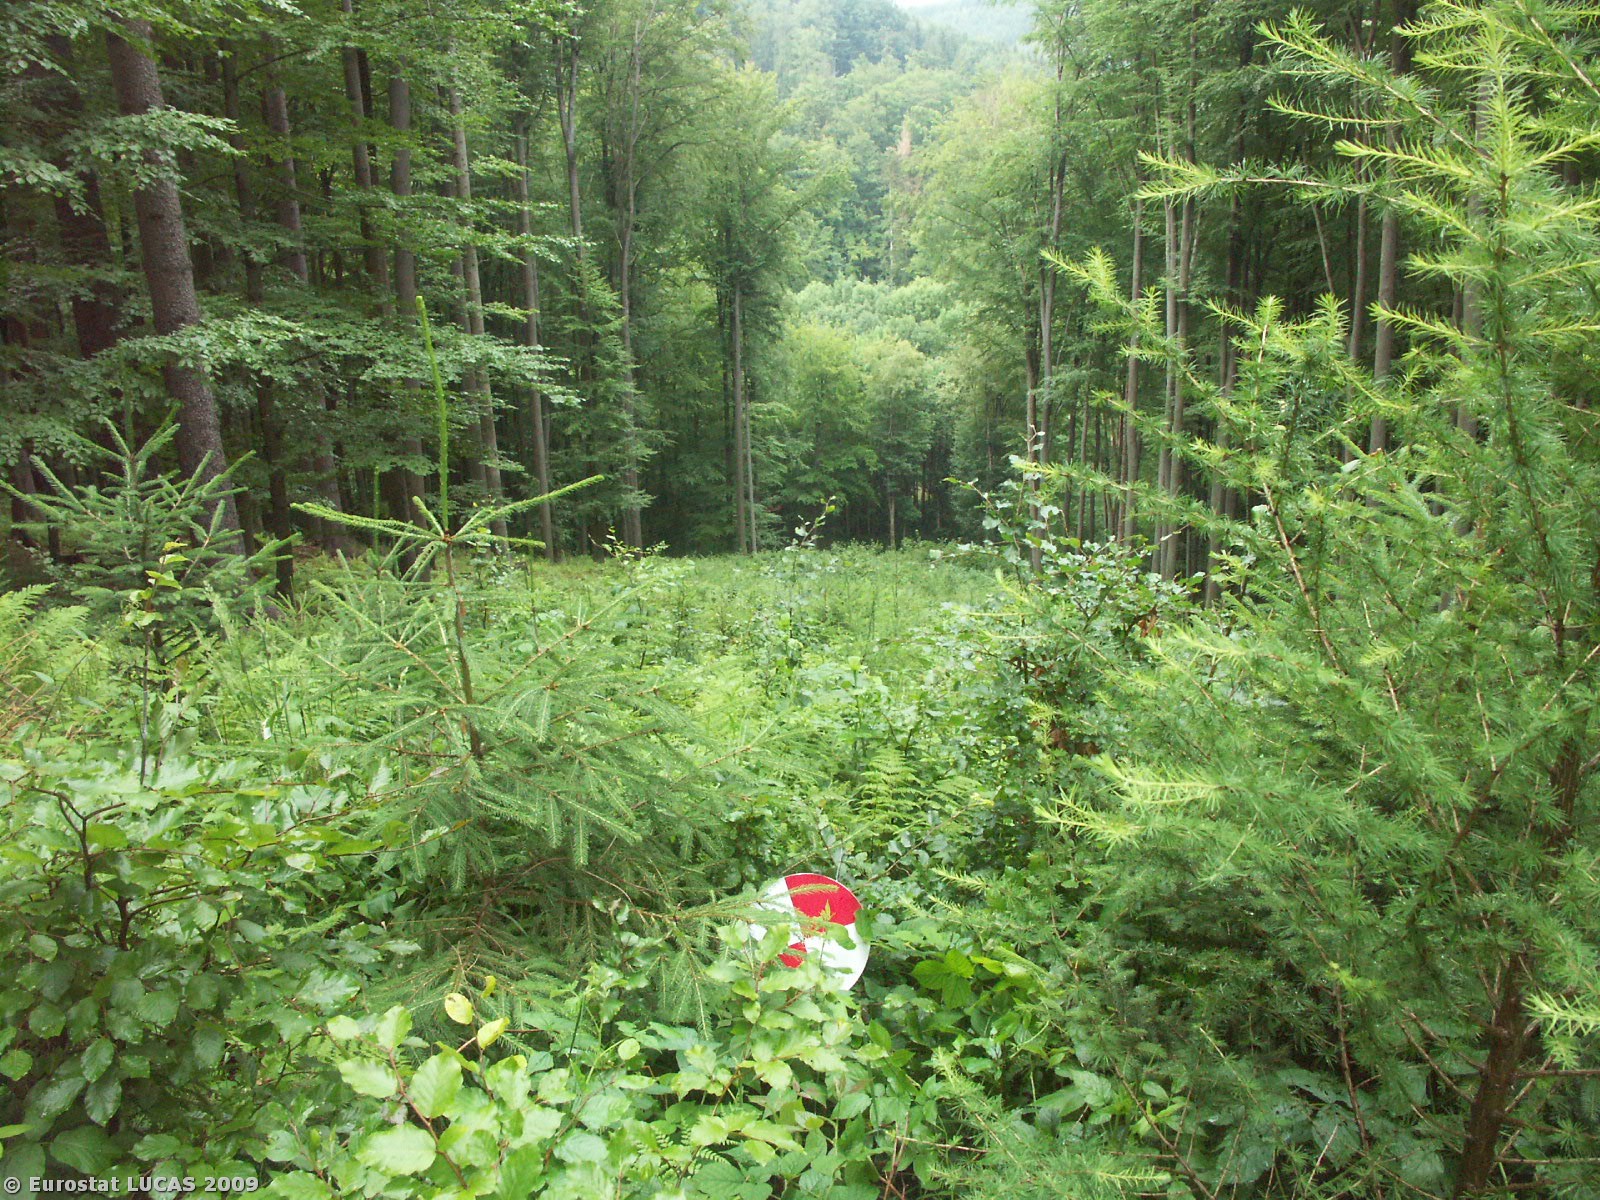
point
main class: Woodland
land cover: Mixed woodland
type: hemiboreal forest and nemoral coniferous forest and mixed broadleaved-coniferous forest
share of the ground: 50 - 75 %
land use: Forestry
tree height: > 5 m
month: July
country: CZ
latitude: 49.8678
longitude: 17.1757
